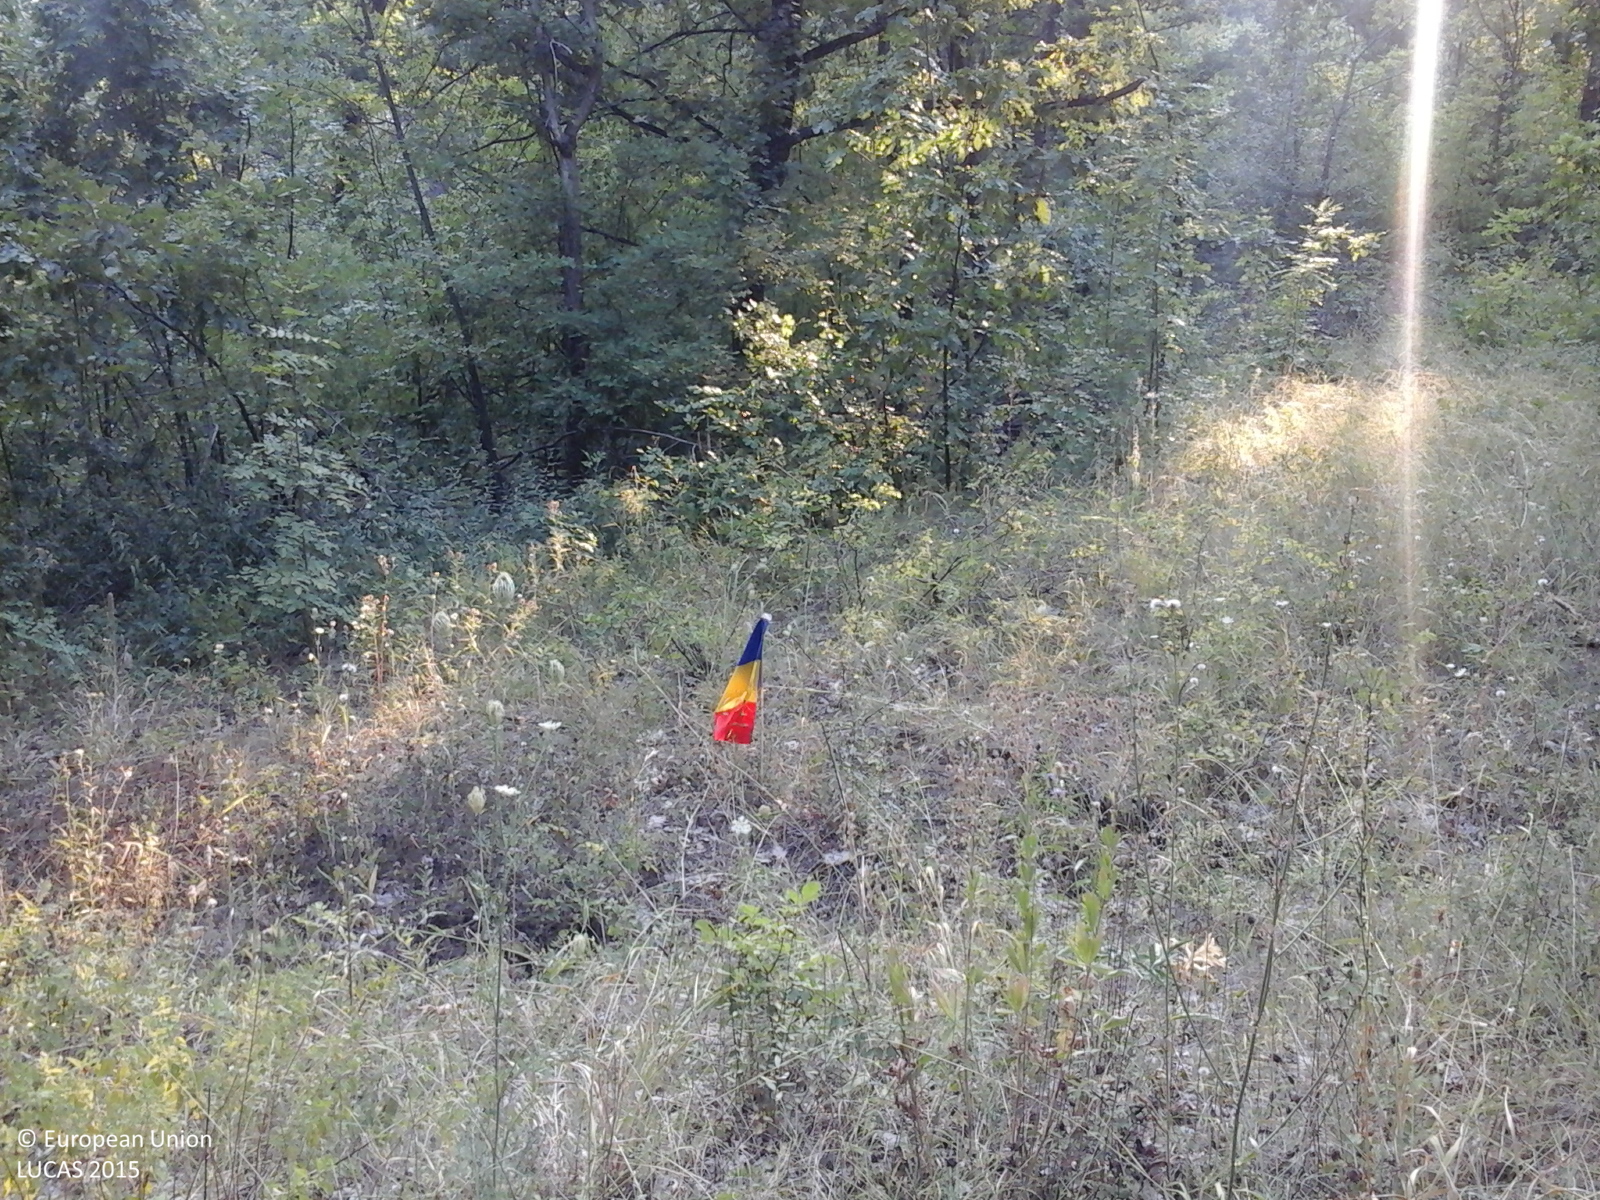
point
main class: Woodland
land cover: Broadleaved woodland
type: acidophilous oak and oak-birch forest
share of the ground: > 75 %
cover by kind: broadleaved forest trees 100 %
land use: Forestry
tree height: > 5 m
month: August
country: RO
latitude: 44.5788
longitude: 23.2100
